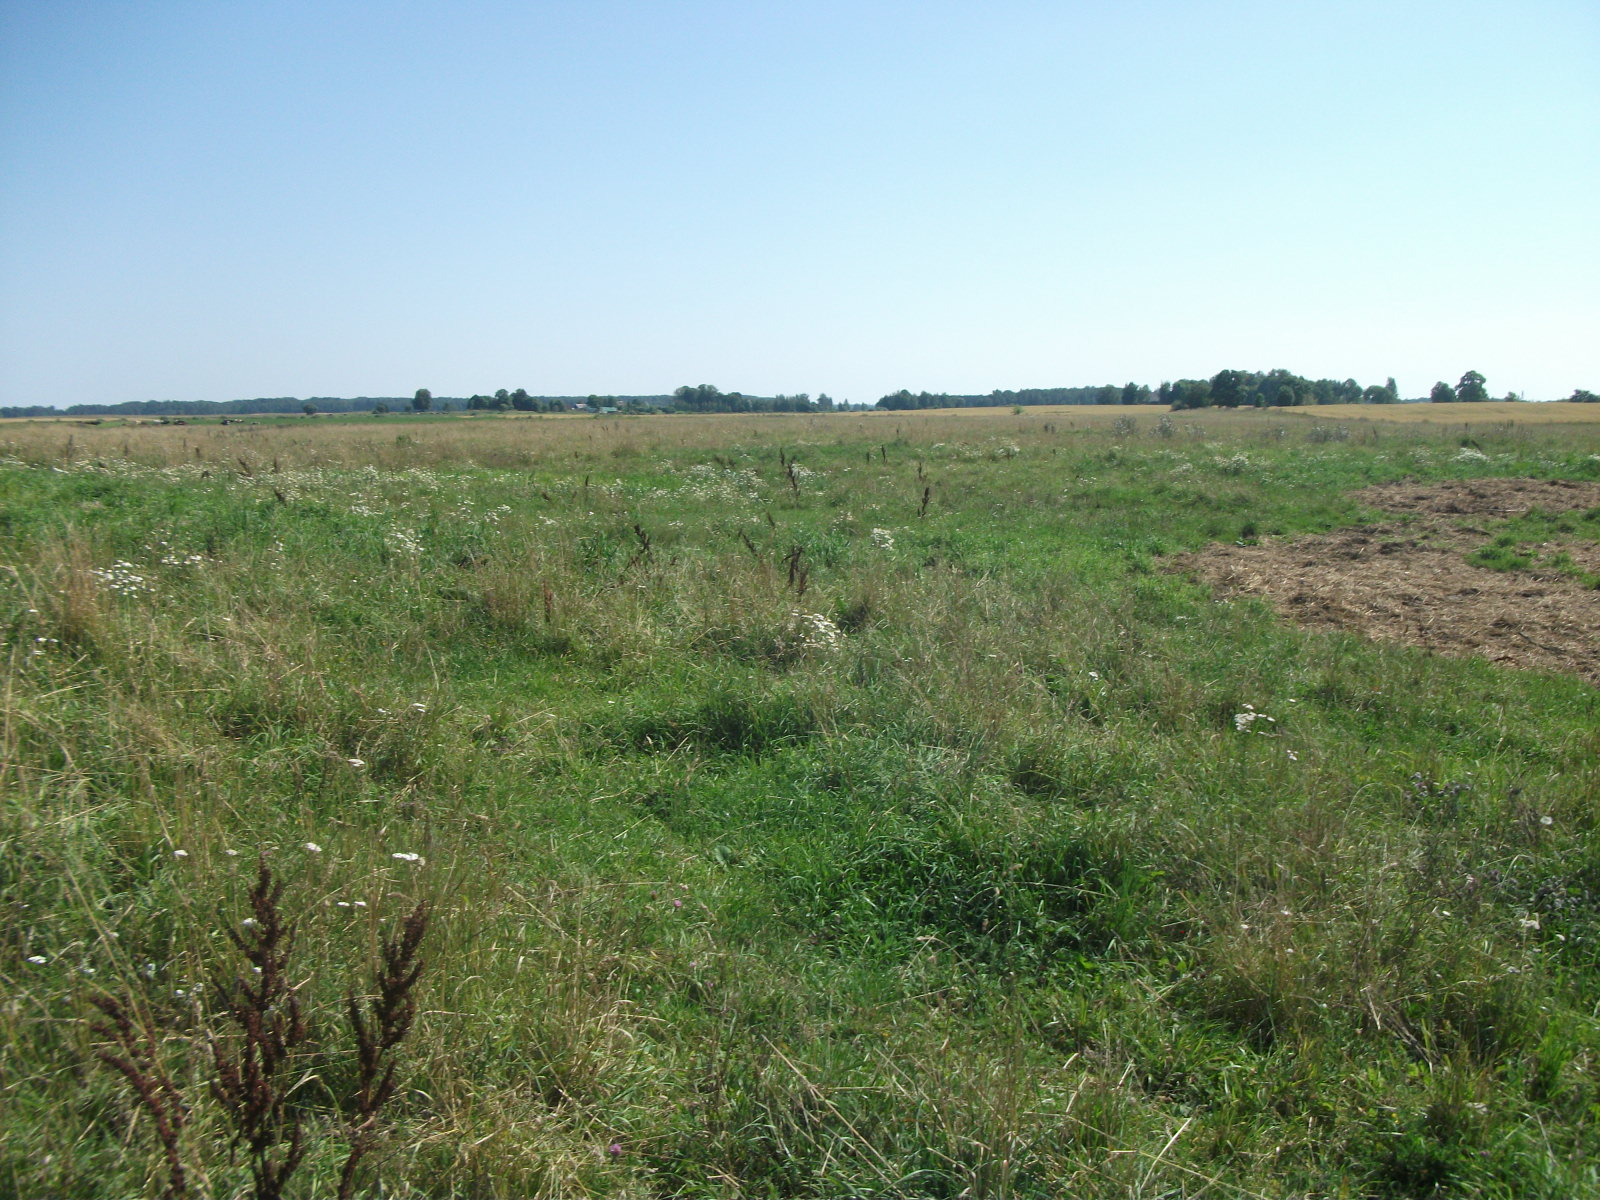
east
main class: Grassland
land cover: Grassland without tree/shrub cover
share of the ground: > 75 %
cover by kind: herbaceous plants 95 %, unconsolidated bare surface 5 %
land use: Agriculture (excluding fallow land and kitchen gardens)
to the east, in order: Grassland without tree/shrub cover; Tracks; Grassland without tree/shrub cover
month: August
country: LV
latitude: 56.6626
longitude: 26.5789
